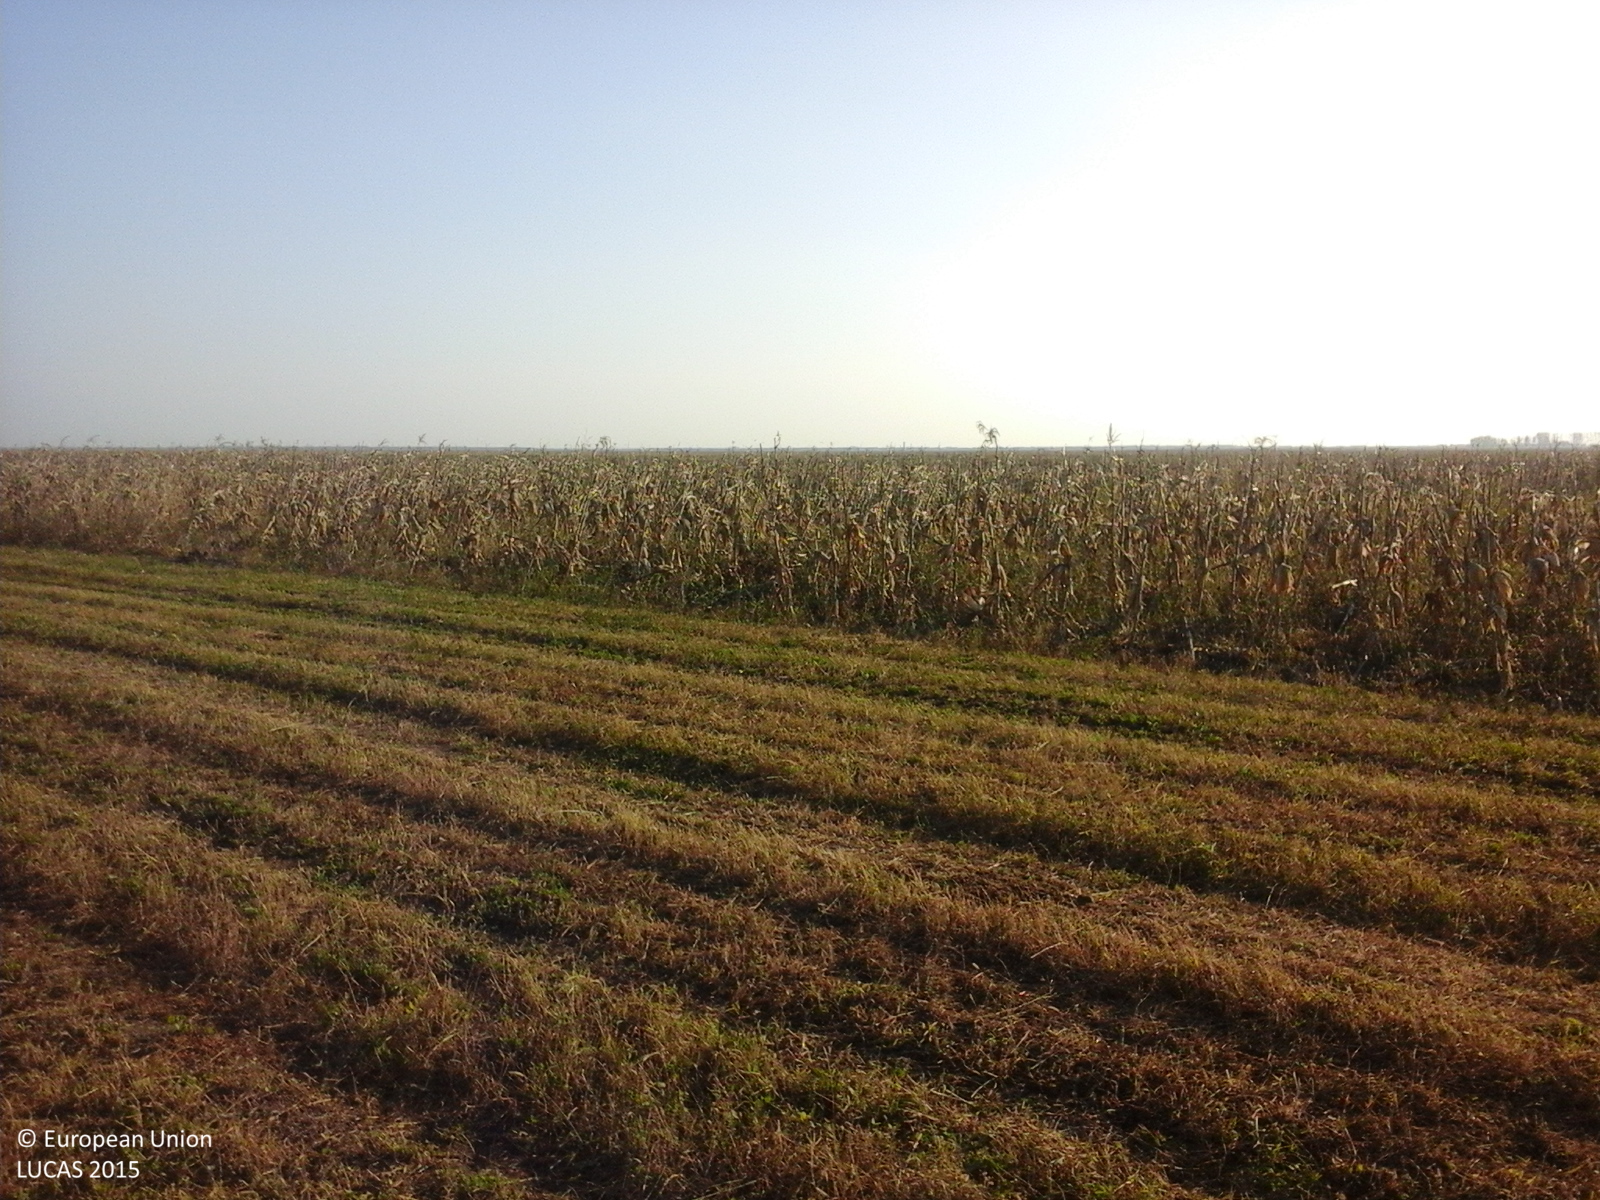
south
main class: Cropland
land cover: Lucerne
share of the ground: > 75 %
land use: Agriculture (excluding fallow land and kitchen gardens)
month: October
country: RO
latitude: 45.1924
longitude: 26.9229
